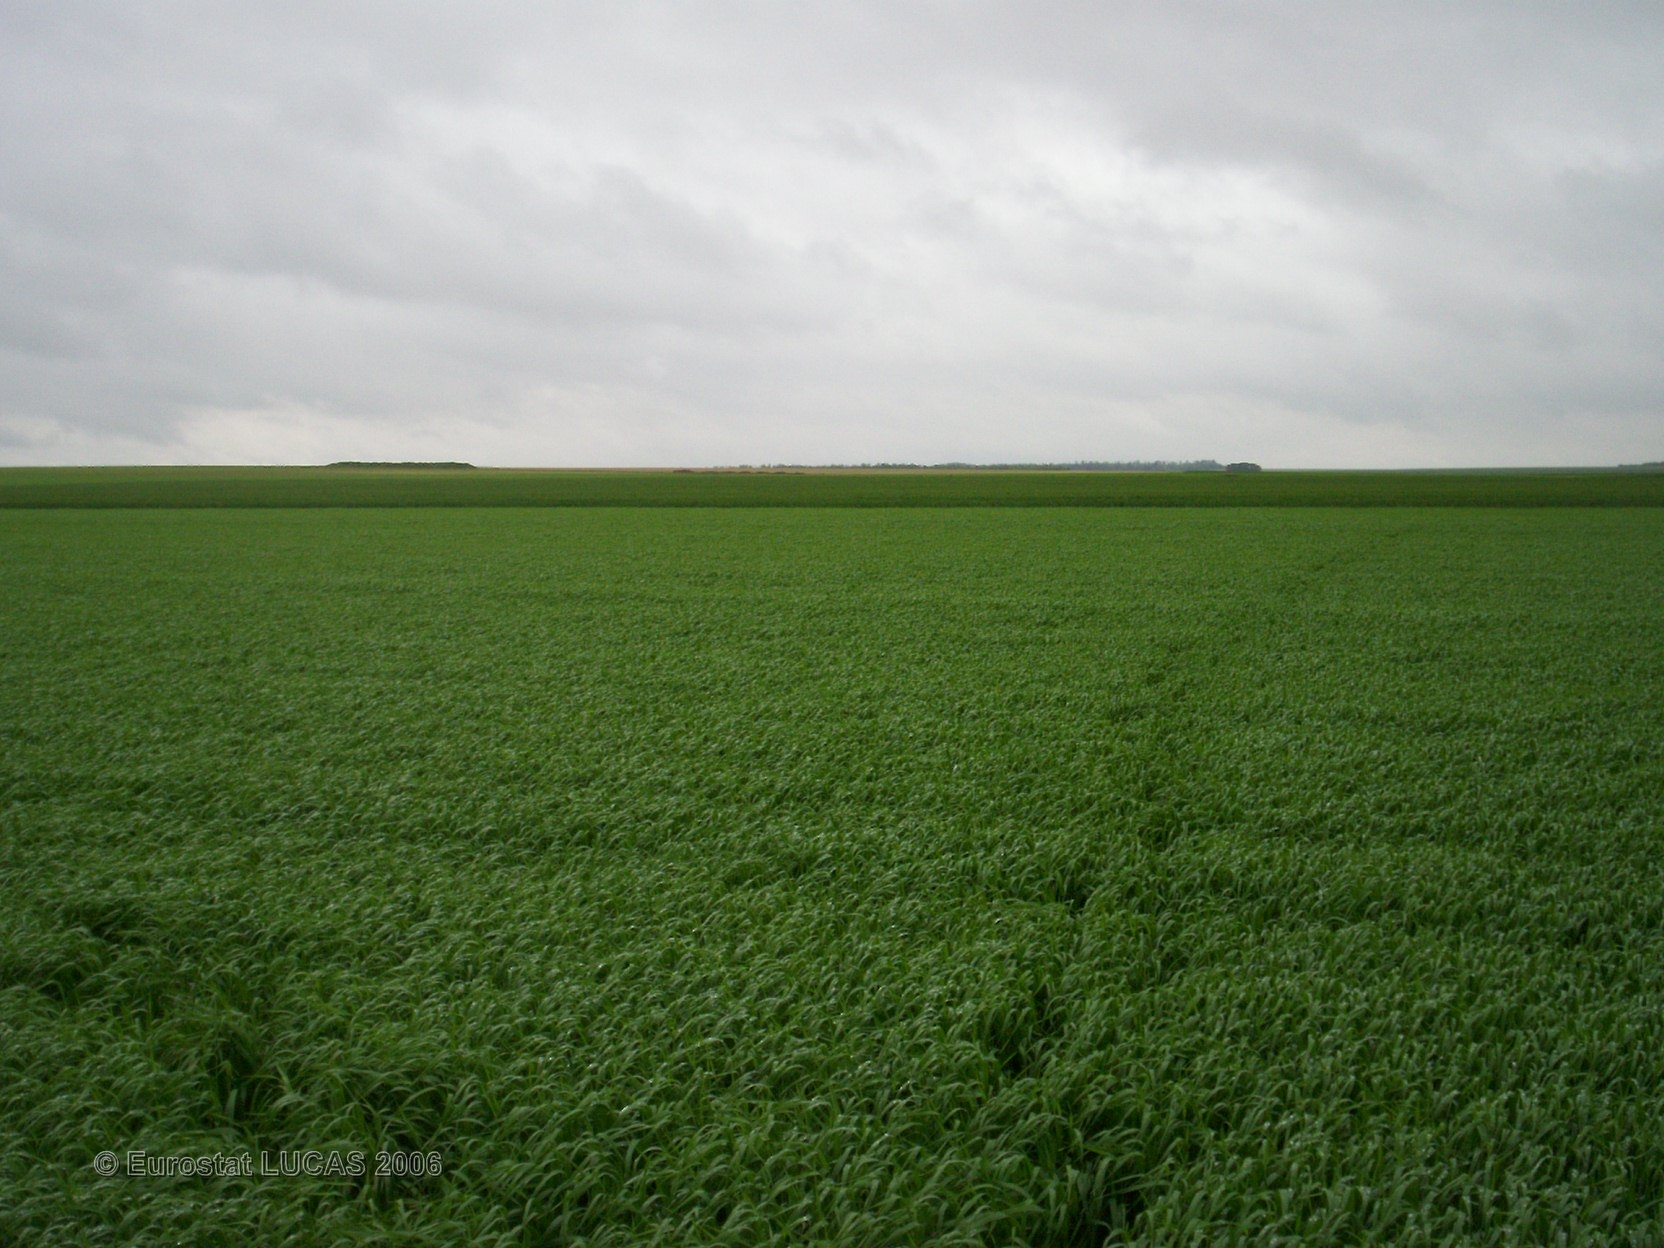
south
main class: Cropland
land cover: Barley
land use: Agriculture (excluding fallow land and kitchen gardens)
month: May
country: FR
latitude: 49.3819
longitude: 4.4450
